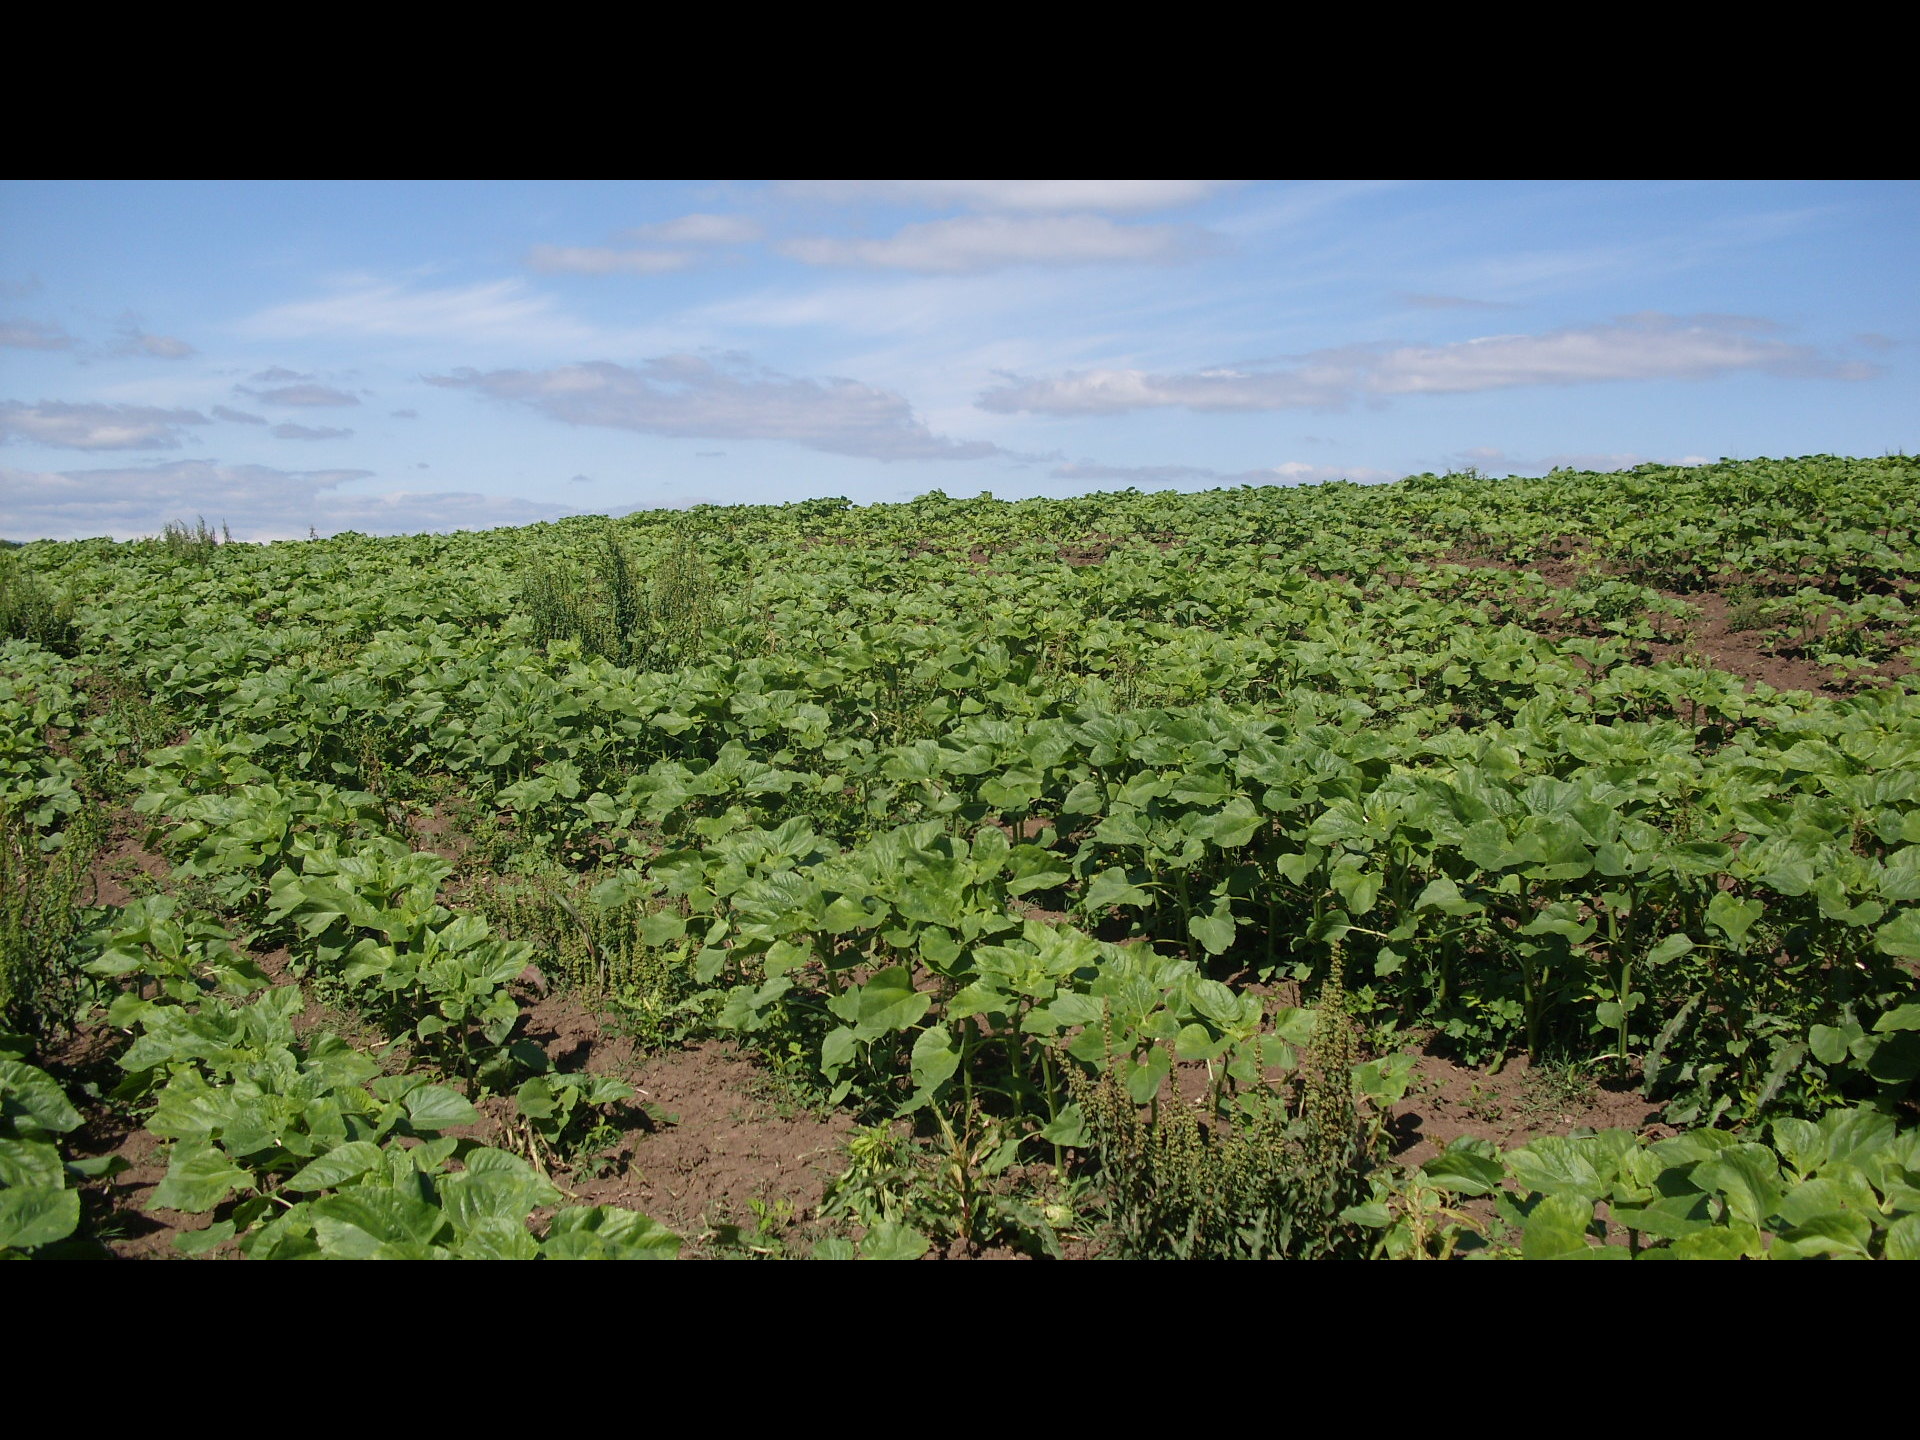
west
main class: Cropland
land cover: Sunflower
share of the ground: > 75 %
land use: Agriculture (excluding fallow land and kitchen gardens)
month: May
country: BG
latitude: 43.3987
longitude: 23.4391
